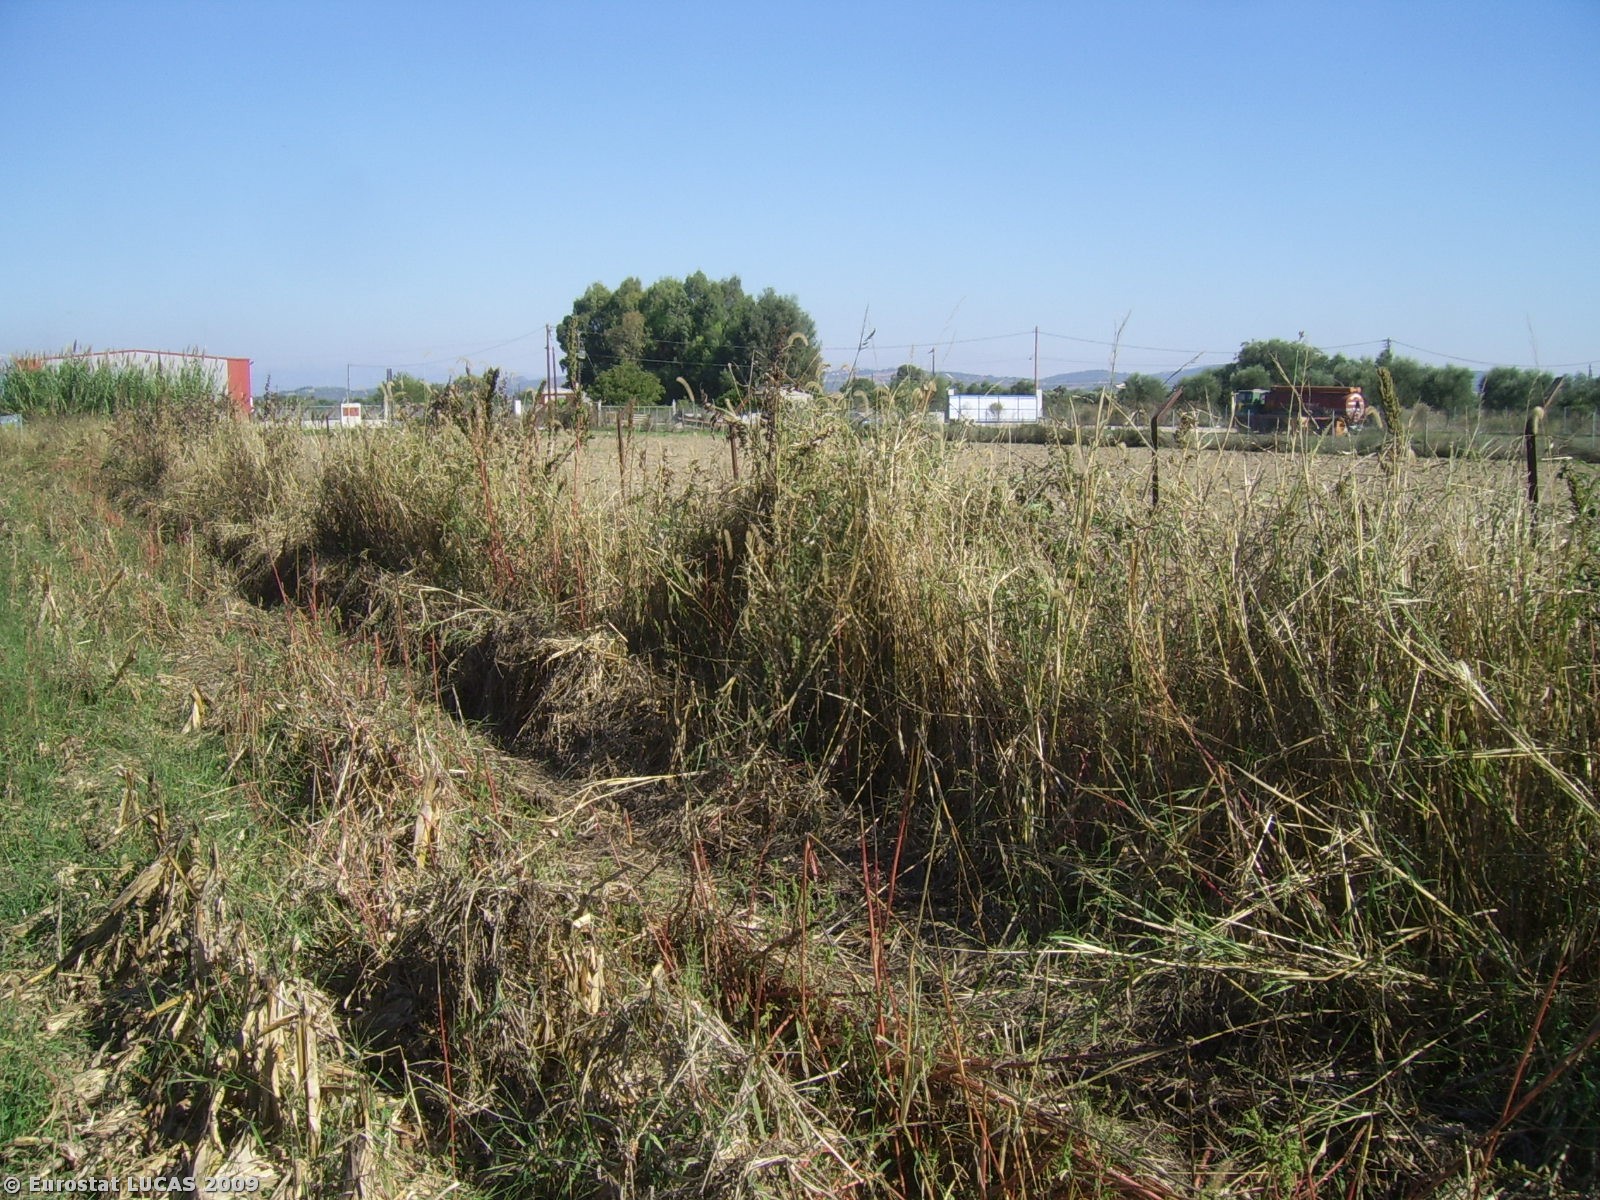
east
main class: Cropland
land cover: Maize
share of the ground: < 10 %
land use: Agriculture (excluding fallow land and kitchen gardens)
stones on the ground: < 10 %
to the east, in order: Maize; Grass margins; Fences; Maize; Shrubland without tree cover; Electric lines; Grass margins; Paved roads, cycling and walking lanes; Grassland without tree/shrub cover; Fences; Shrubland without tree cover; Grassland without tree/shrub cover; Fences; Grassland without tree/shrub cover; Broadleaved woodland
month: October
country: GR
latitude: 37.8207
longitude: 21.3088
